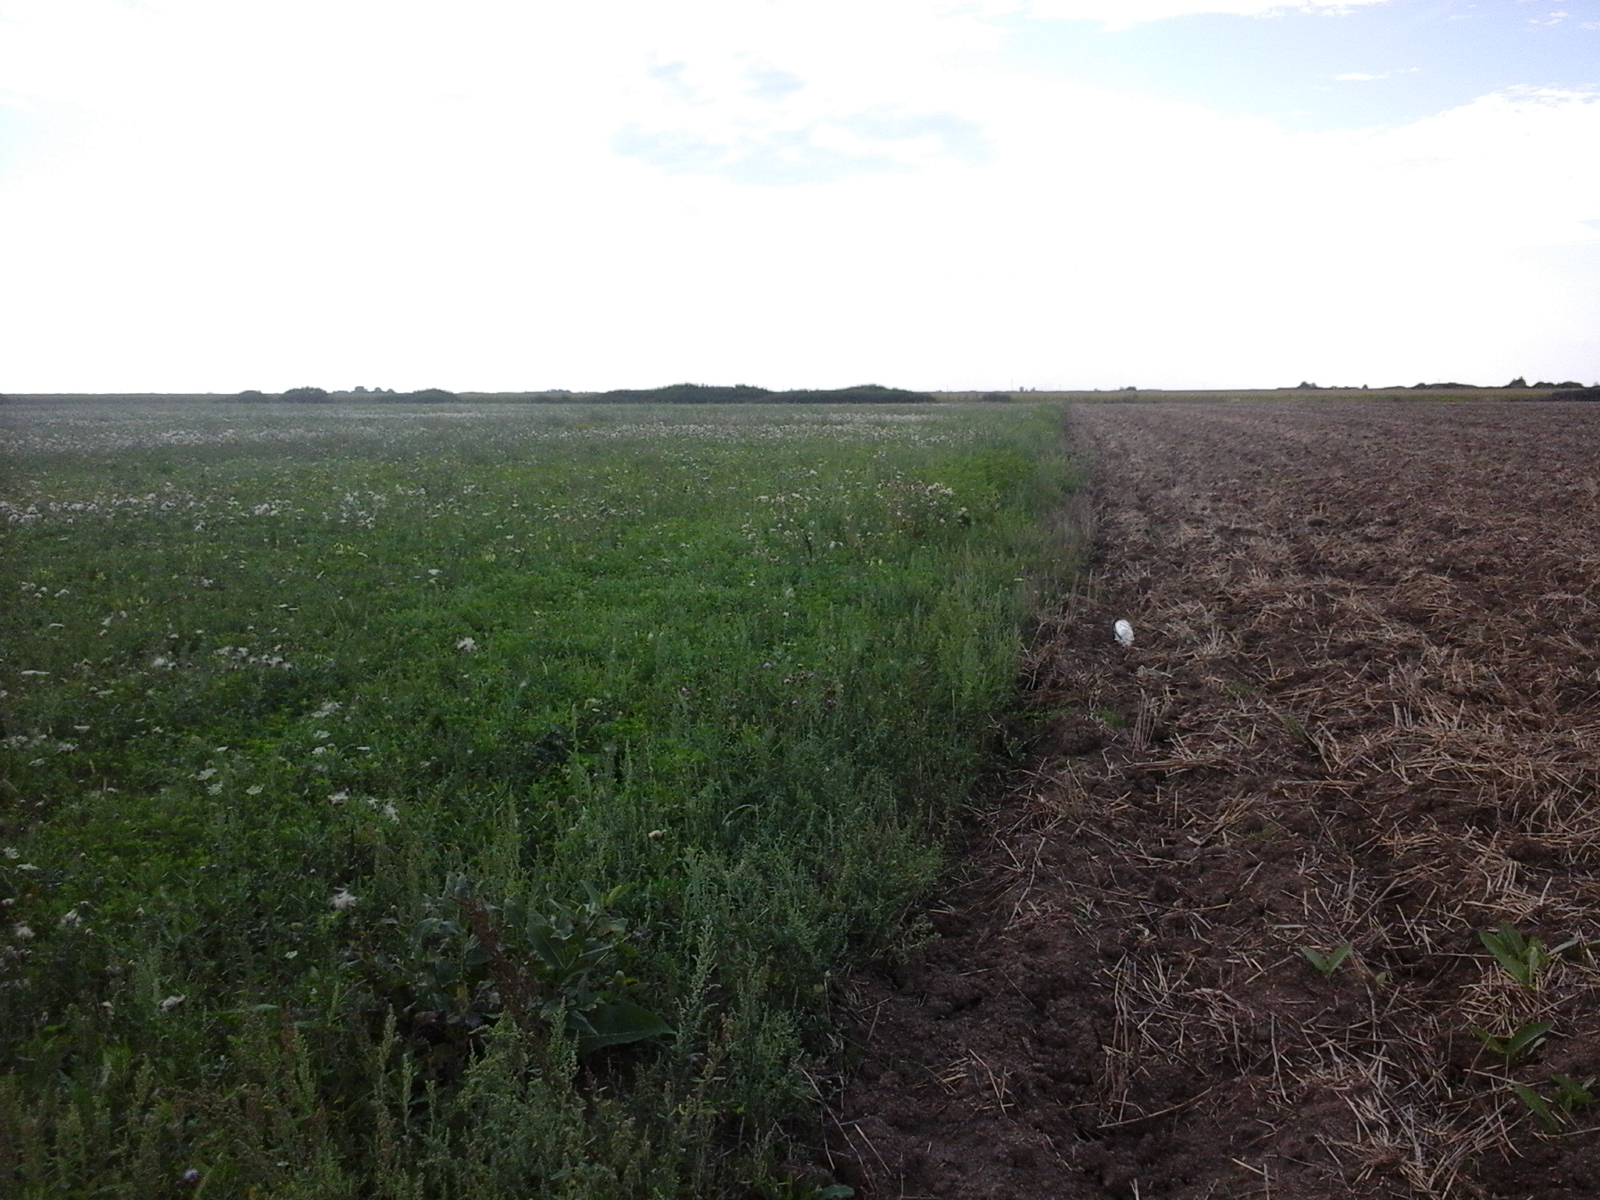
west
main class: Cropland
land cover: Common wheat
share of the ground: < 10 %
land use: Agriculture (excluding fallow land and kitchen gardens)
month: August
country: RO
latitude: 46.7310
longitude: 21.6479
